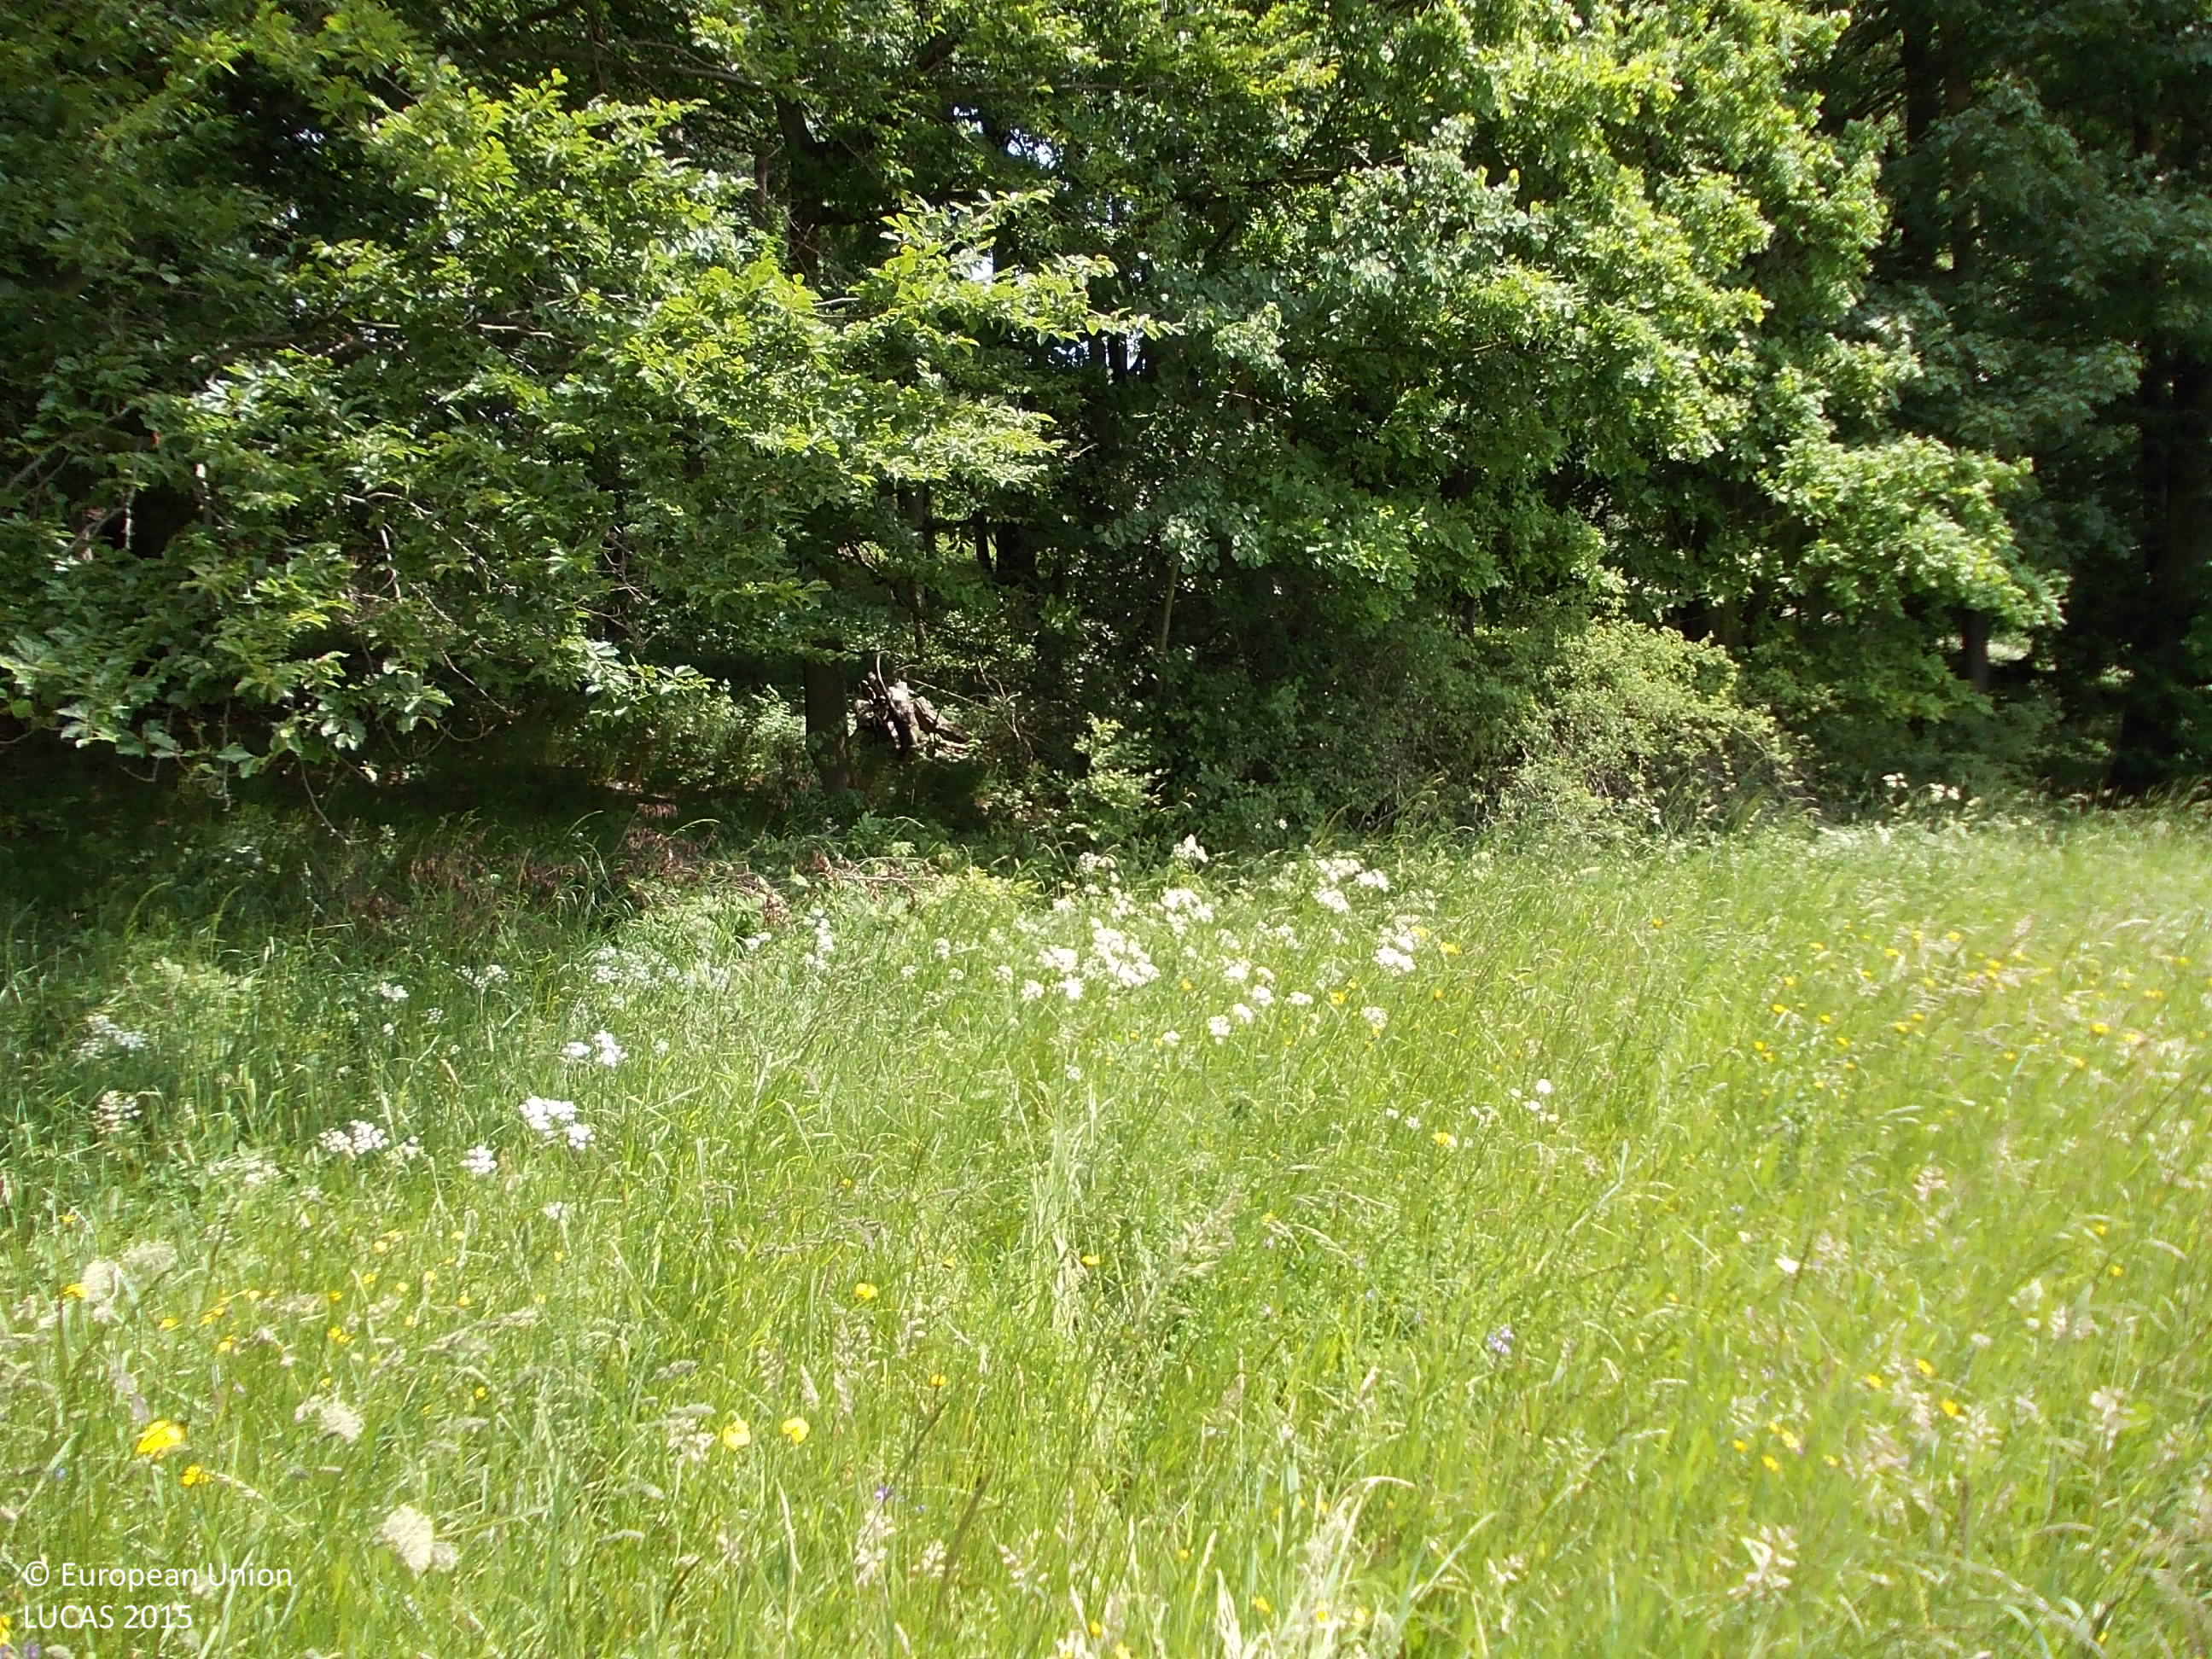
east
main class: Grassland
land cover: Grassland without tree/shrub cover
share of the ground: > 75 %
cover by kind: herbaceous plants 100 %
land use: Agriculture (excluding fallow land and kitchen gardens)
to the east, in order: Grassland without tree/shrub cover; Broadleaved woodland; Grassland without tree/shrub cover
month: June
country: CZ
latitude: 50.5798
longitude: 16.4331
